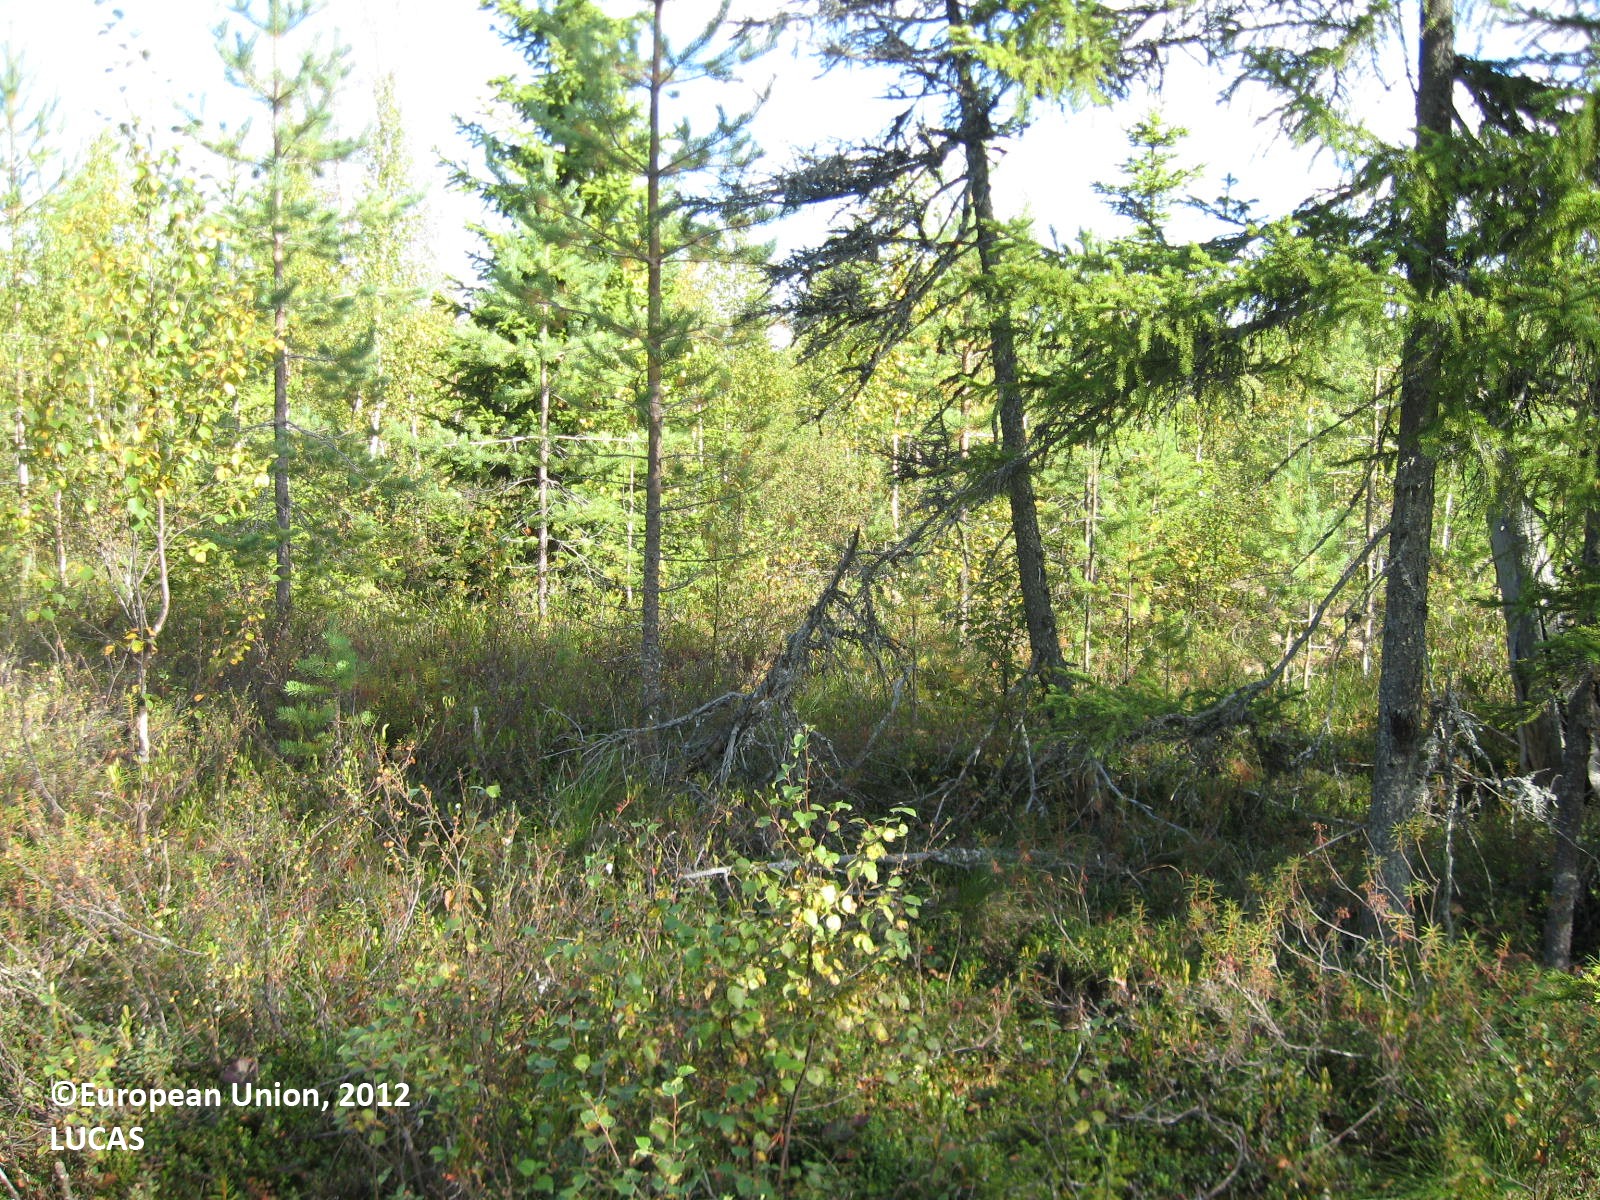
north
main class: Woodland
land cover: Other coniferous woodland
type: boreal forest
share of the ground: 50 - 75 %
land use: Forestry
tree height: < 5 m
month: August
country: FI
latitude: 63.7930
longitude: 29.7373
